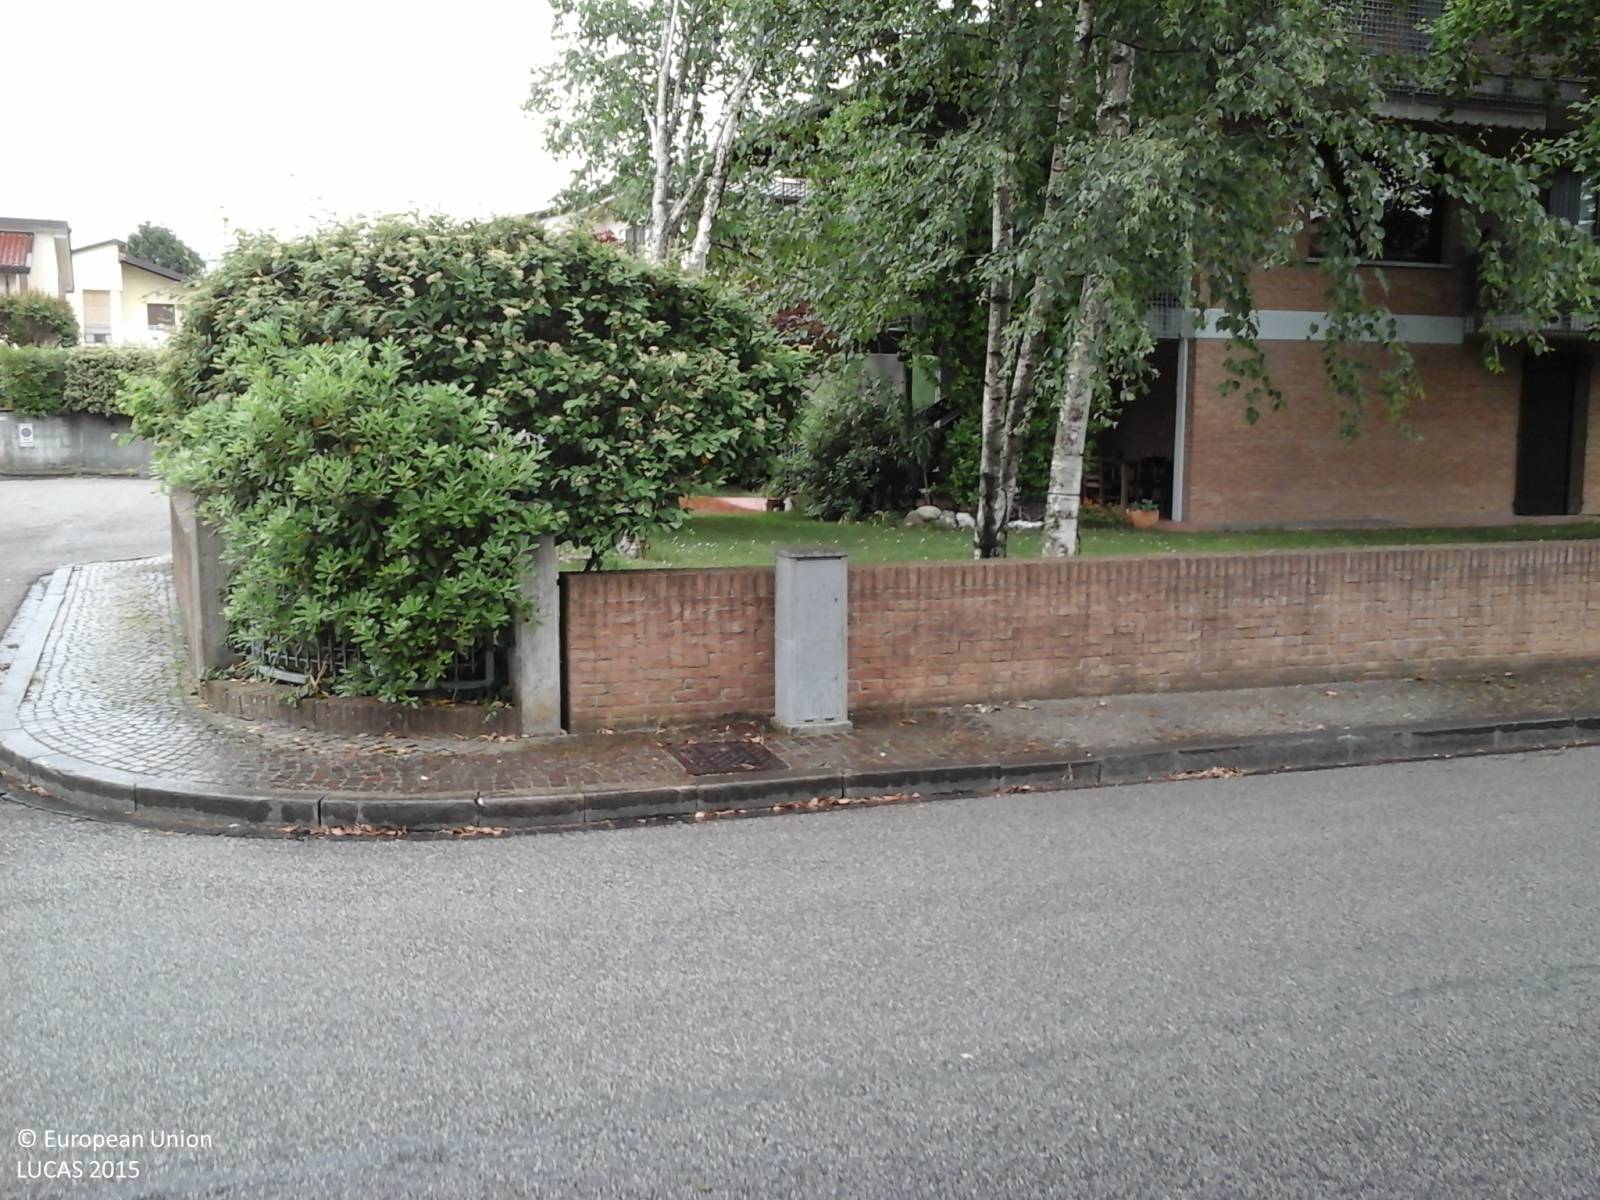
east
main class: Woodland
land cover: Broadleaved woodland
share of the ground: > 75 %
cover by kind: broadleaved forest trees 80 %, herbaceous plants 20 %
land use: Amenities, museums, leisure
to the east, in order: Broadleaved woodland; Artificial constructions in urban areas
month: May
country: IT
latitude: 46.0834
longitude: 13.3199
